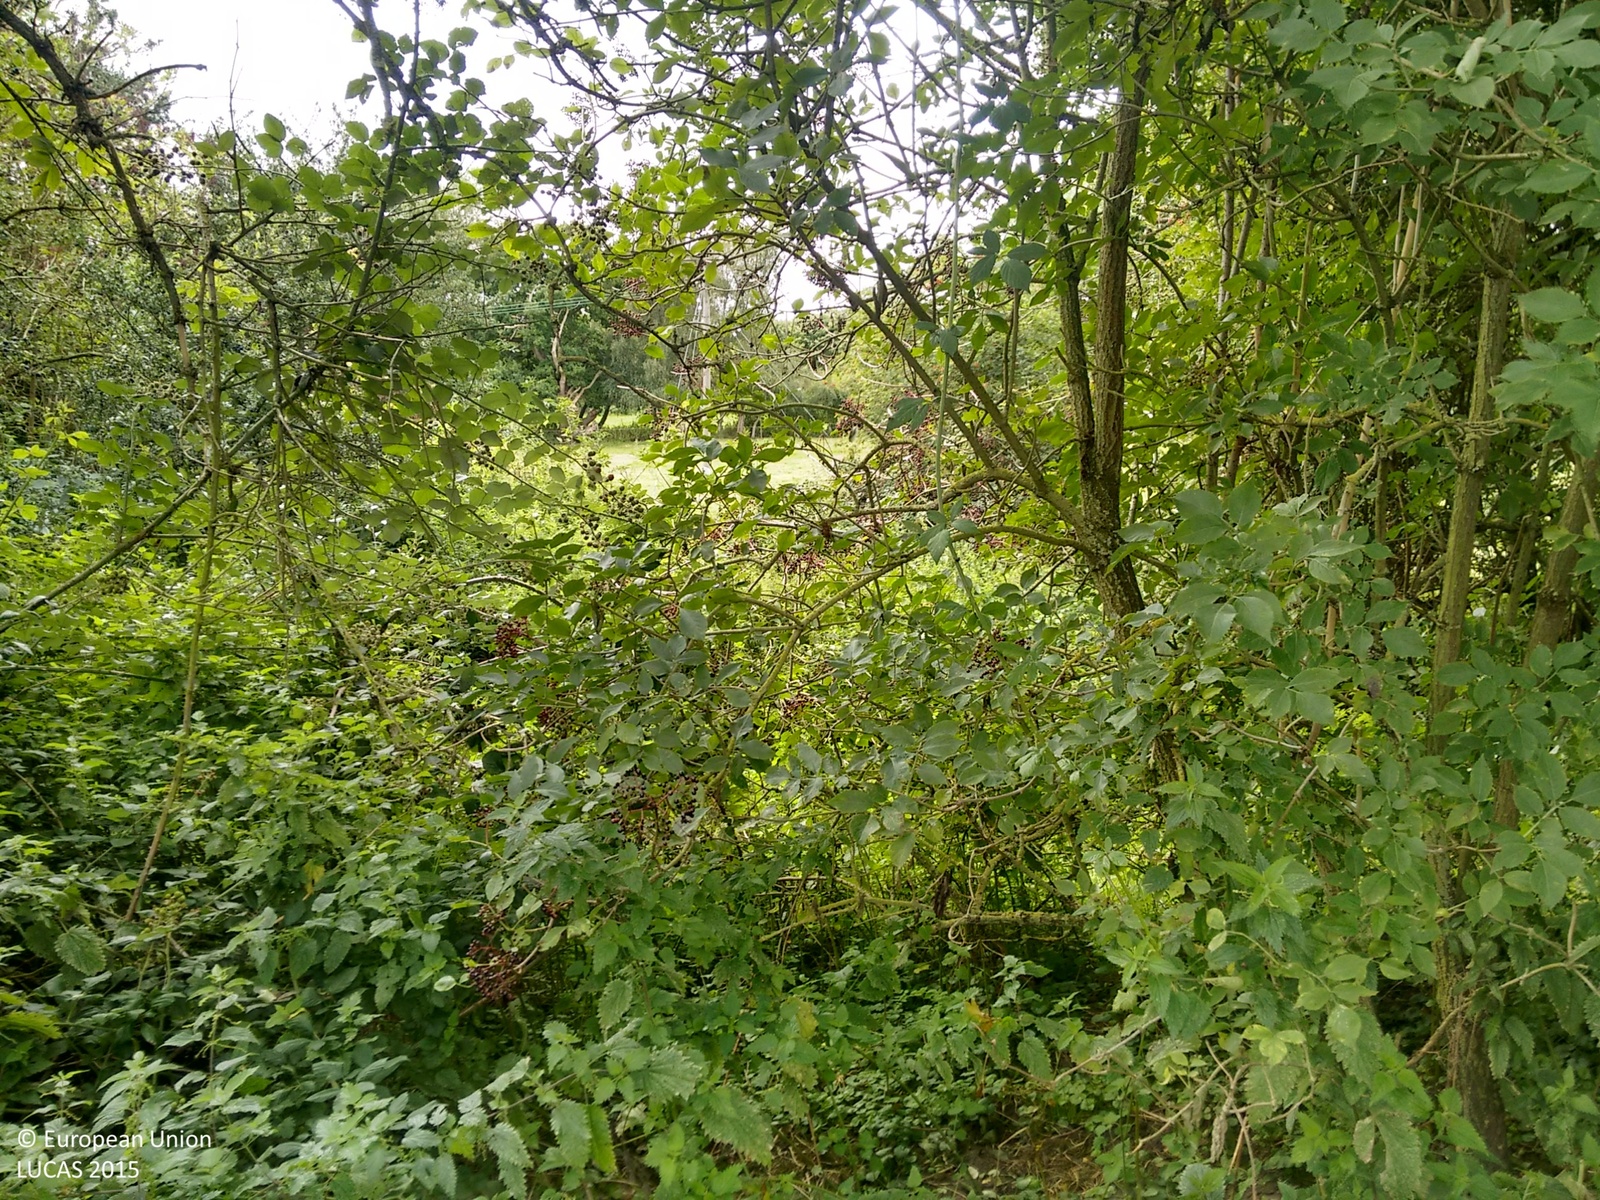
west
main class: Grassland
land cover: Grassland without tree/shrub cover
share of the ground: > 75 %
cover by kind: herbaceous plants 100 %
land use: Agriculture (excluding fallow land and kitchen gardens)
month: September
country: GB
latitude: 52.2297
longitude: 0.9428
